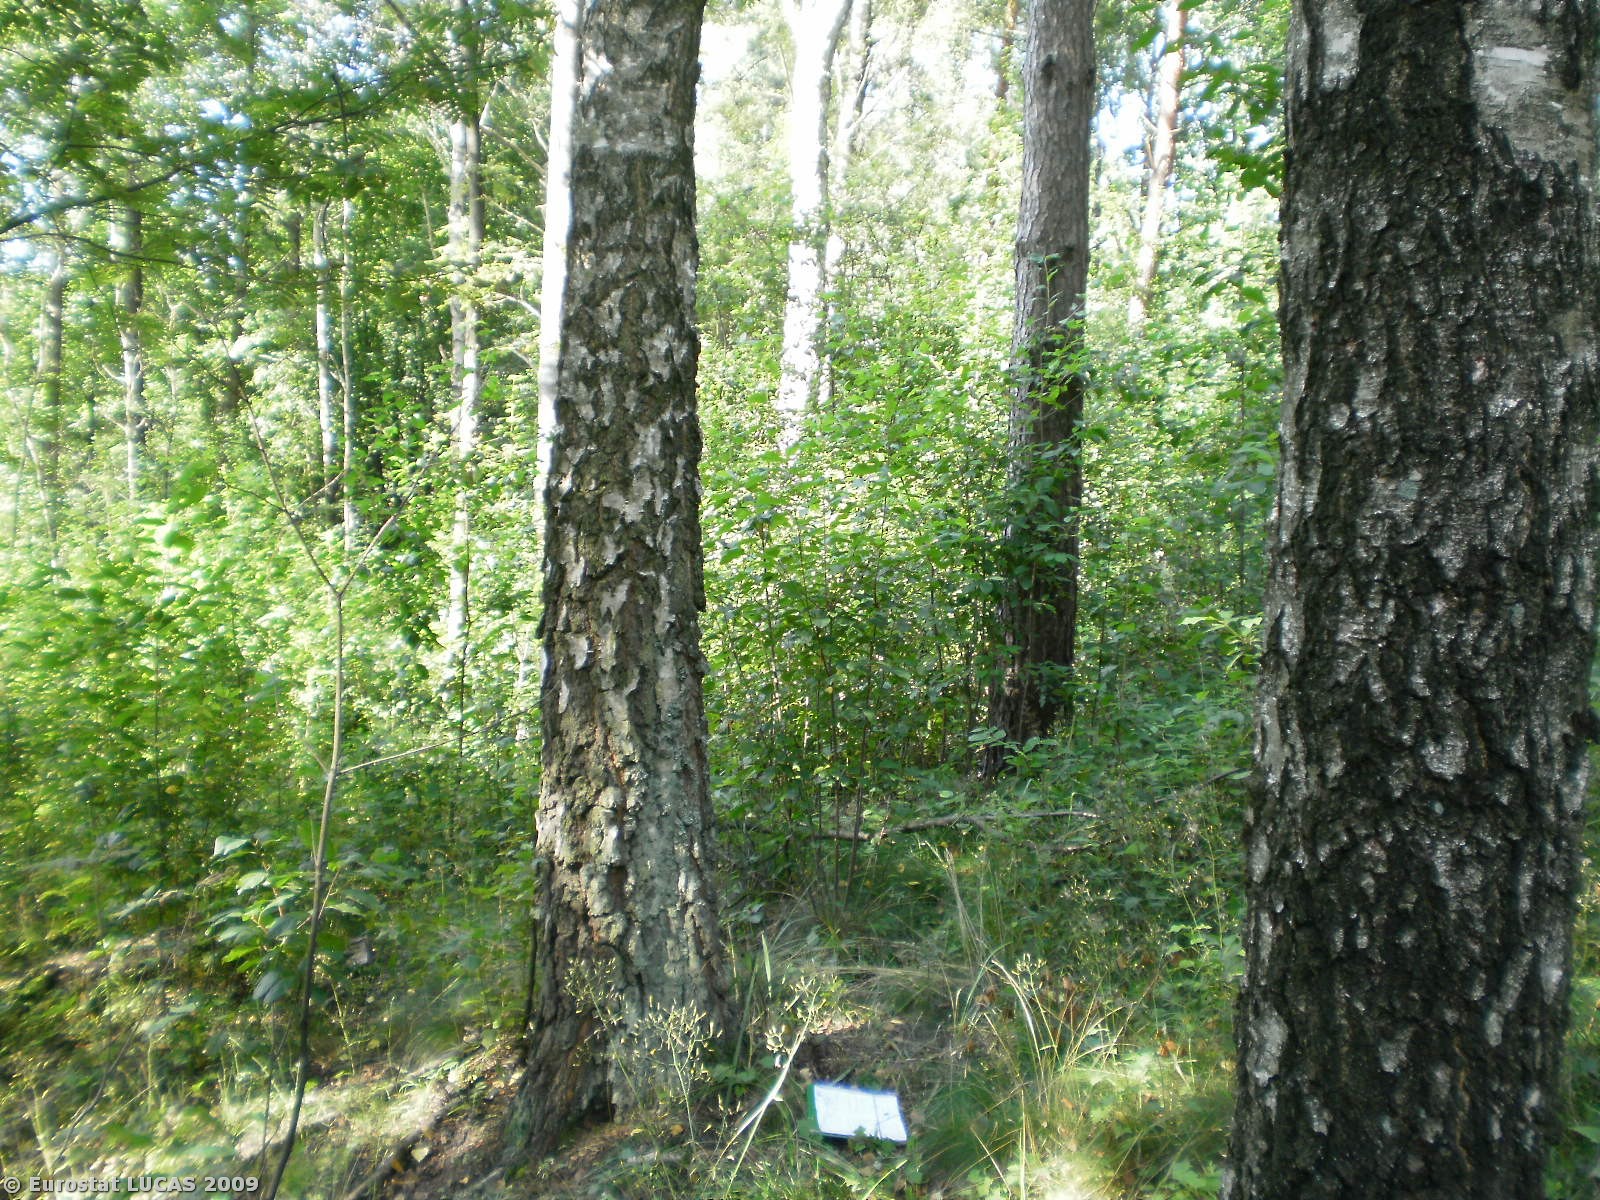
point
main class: Woodland
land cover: Broadleaved woodland
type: mesophytic deciduous forest
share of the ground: > 75 %
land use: Forestry
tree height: > 5 m
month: August
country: PL
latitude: 54.0401
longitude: 20.6202
